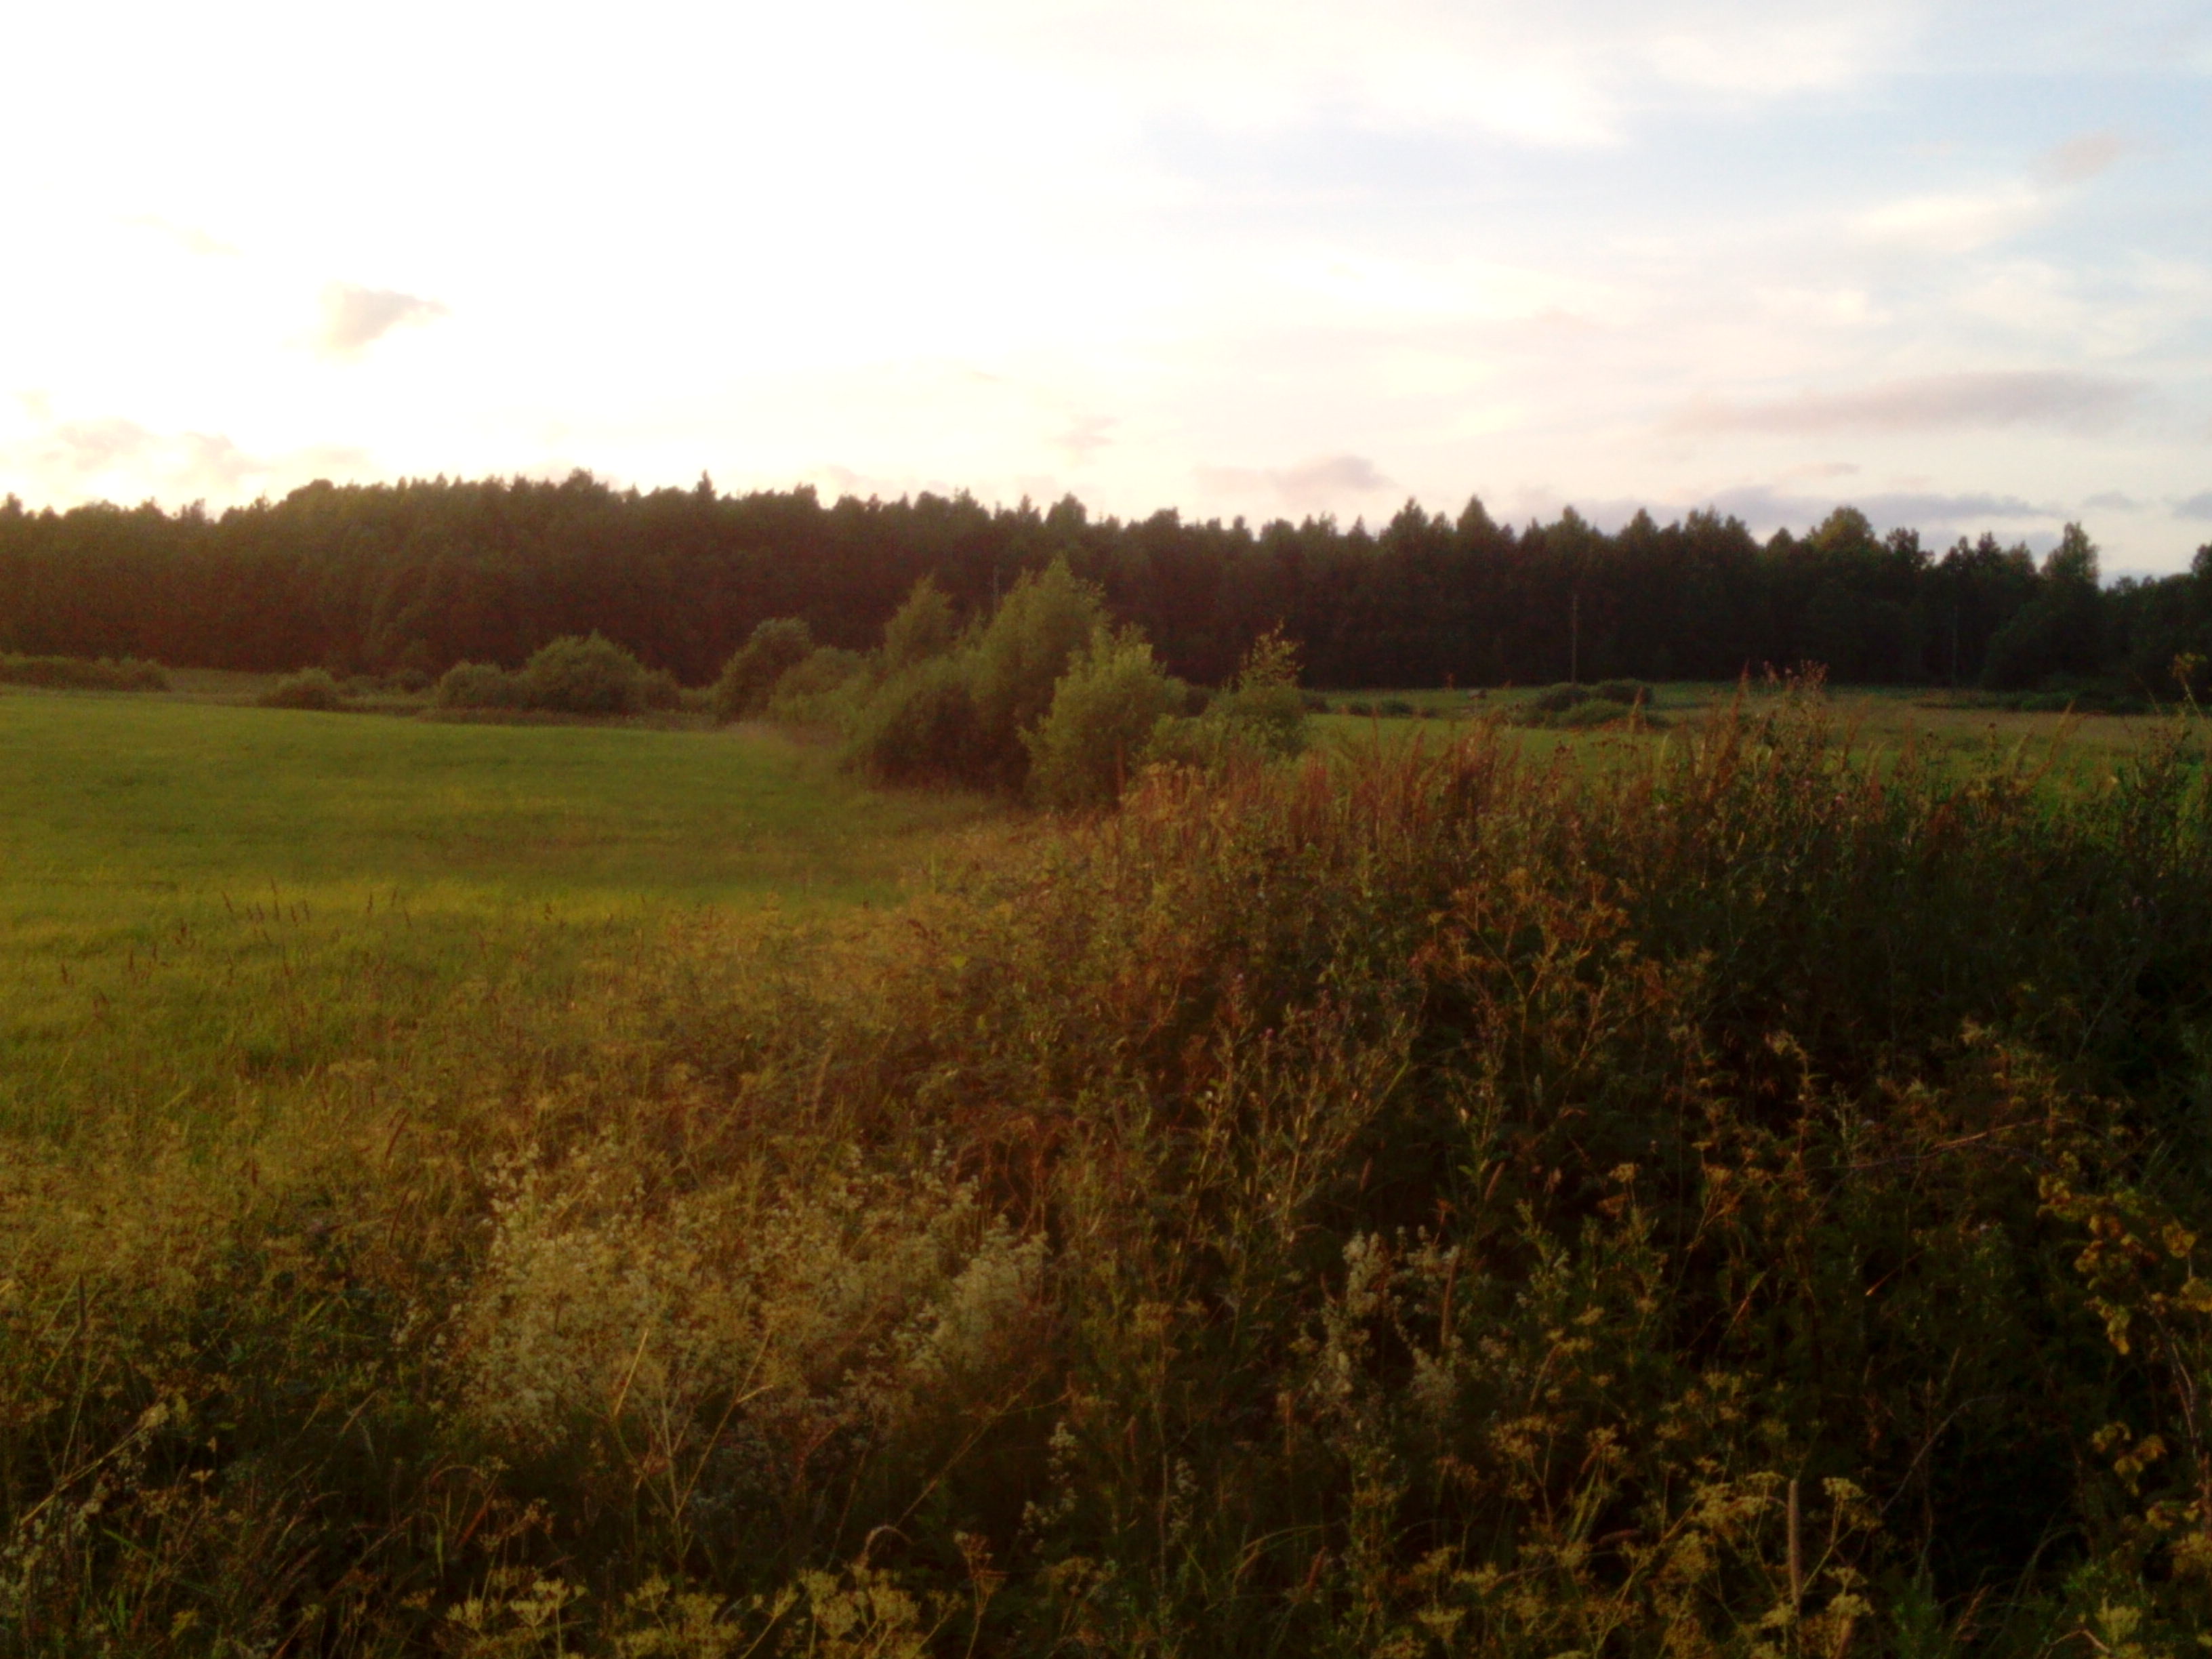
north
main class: Grassland
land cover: Spontaneously vegetated surfaces
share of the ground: > 75 %
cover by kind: herbaceous plants 90 %
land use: Semi-natural and natural areas not in use
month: July
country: LV
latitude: 56.3526
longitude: 21.7791
